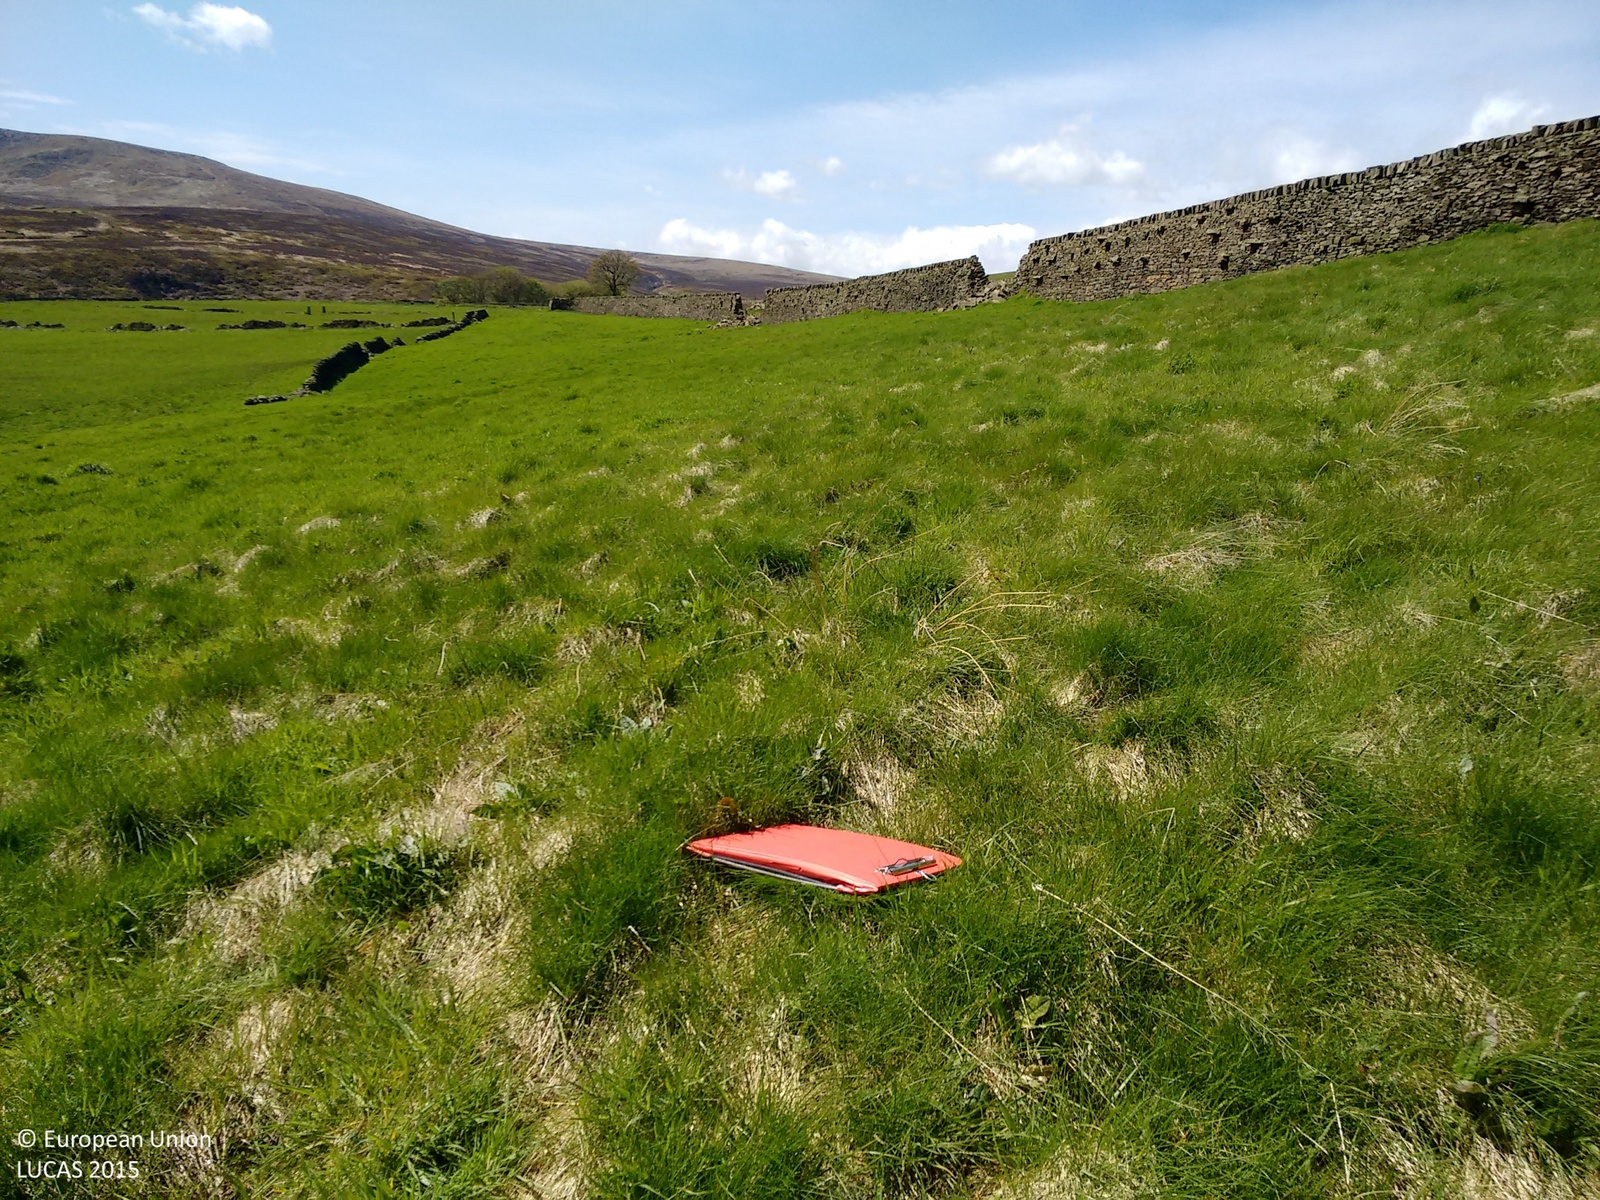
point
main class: Grassland
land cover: Grassland without tree/shrub cover
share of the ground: > 75 %
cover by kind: herbaceous plants 100 %
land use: Agriculture (excluding fallow land and kitchen gardens)
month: May
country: GB
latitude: 53.5634
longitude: -1.8466
